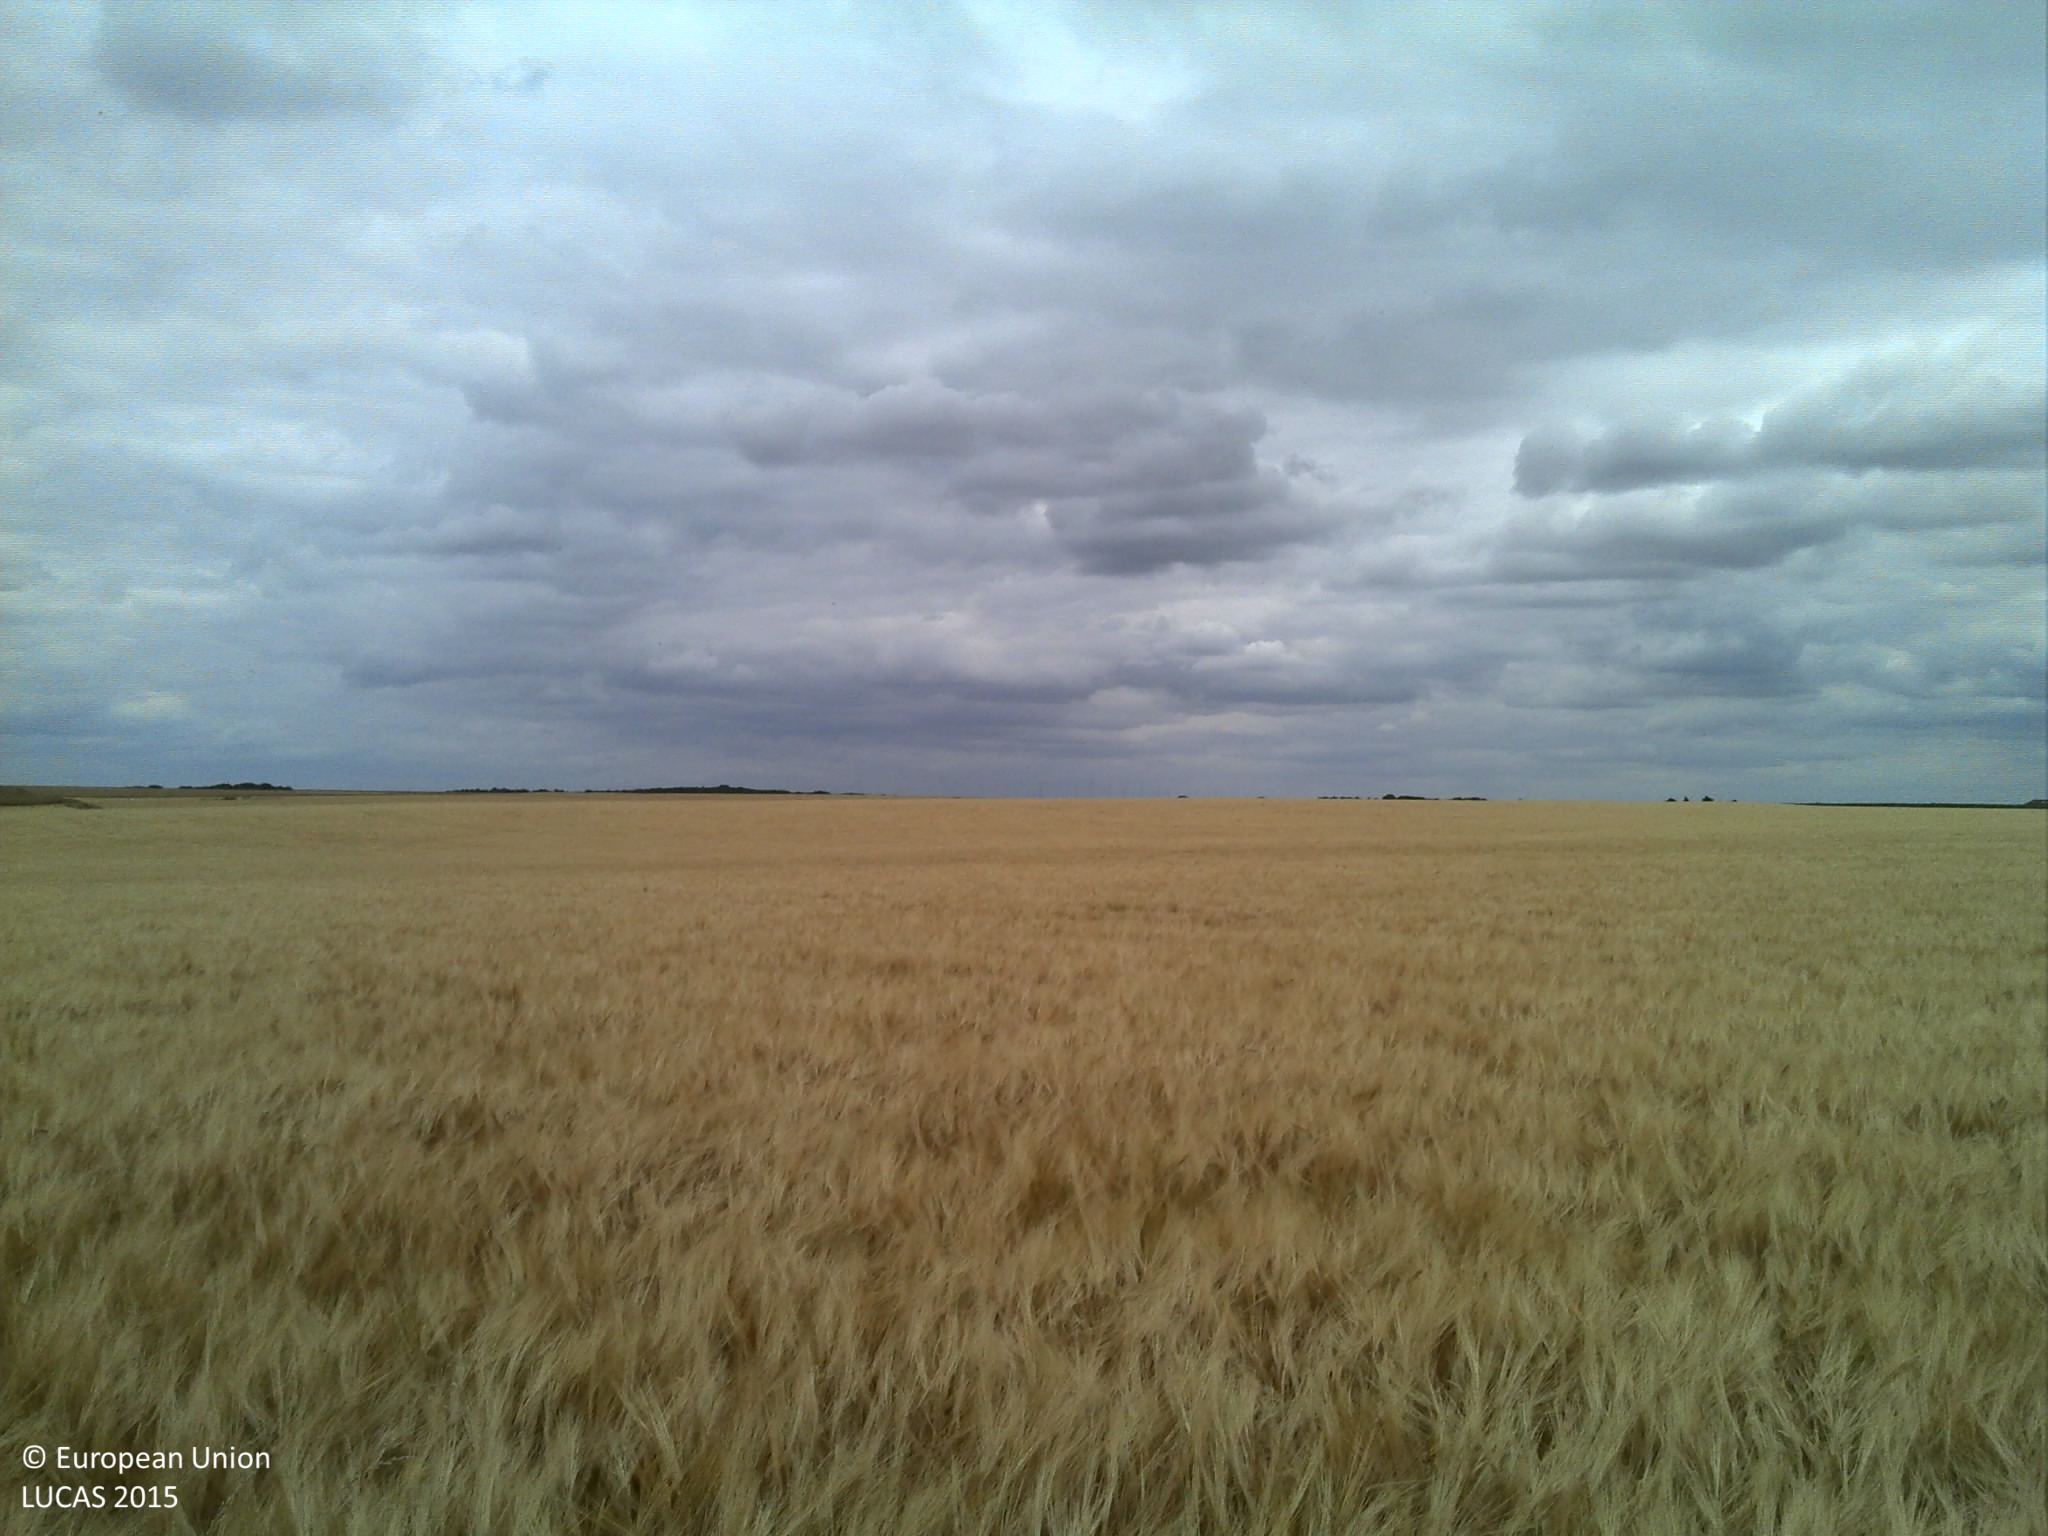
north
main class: Cropland
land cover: Barley
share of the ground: > 75 %
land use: Agriculture (excluding fallow land and kitchen gardens)
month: July
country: FR
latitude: 48.4868
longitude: 2.4256
